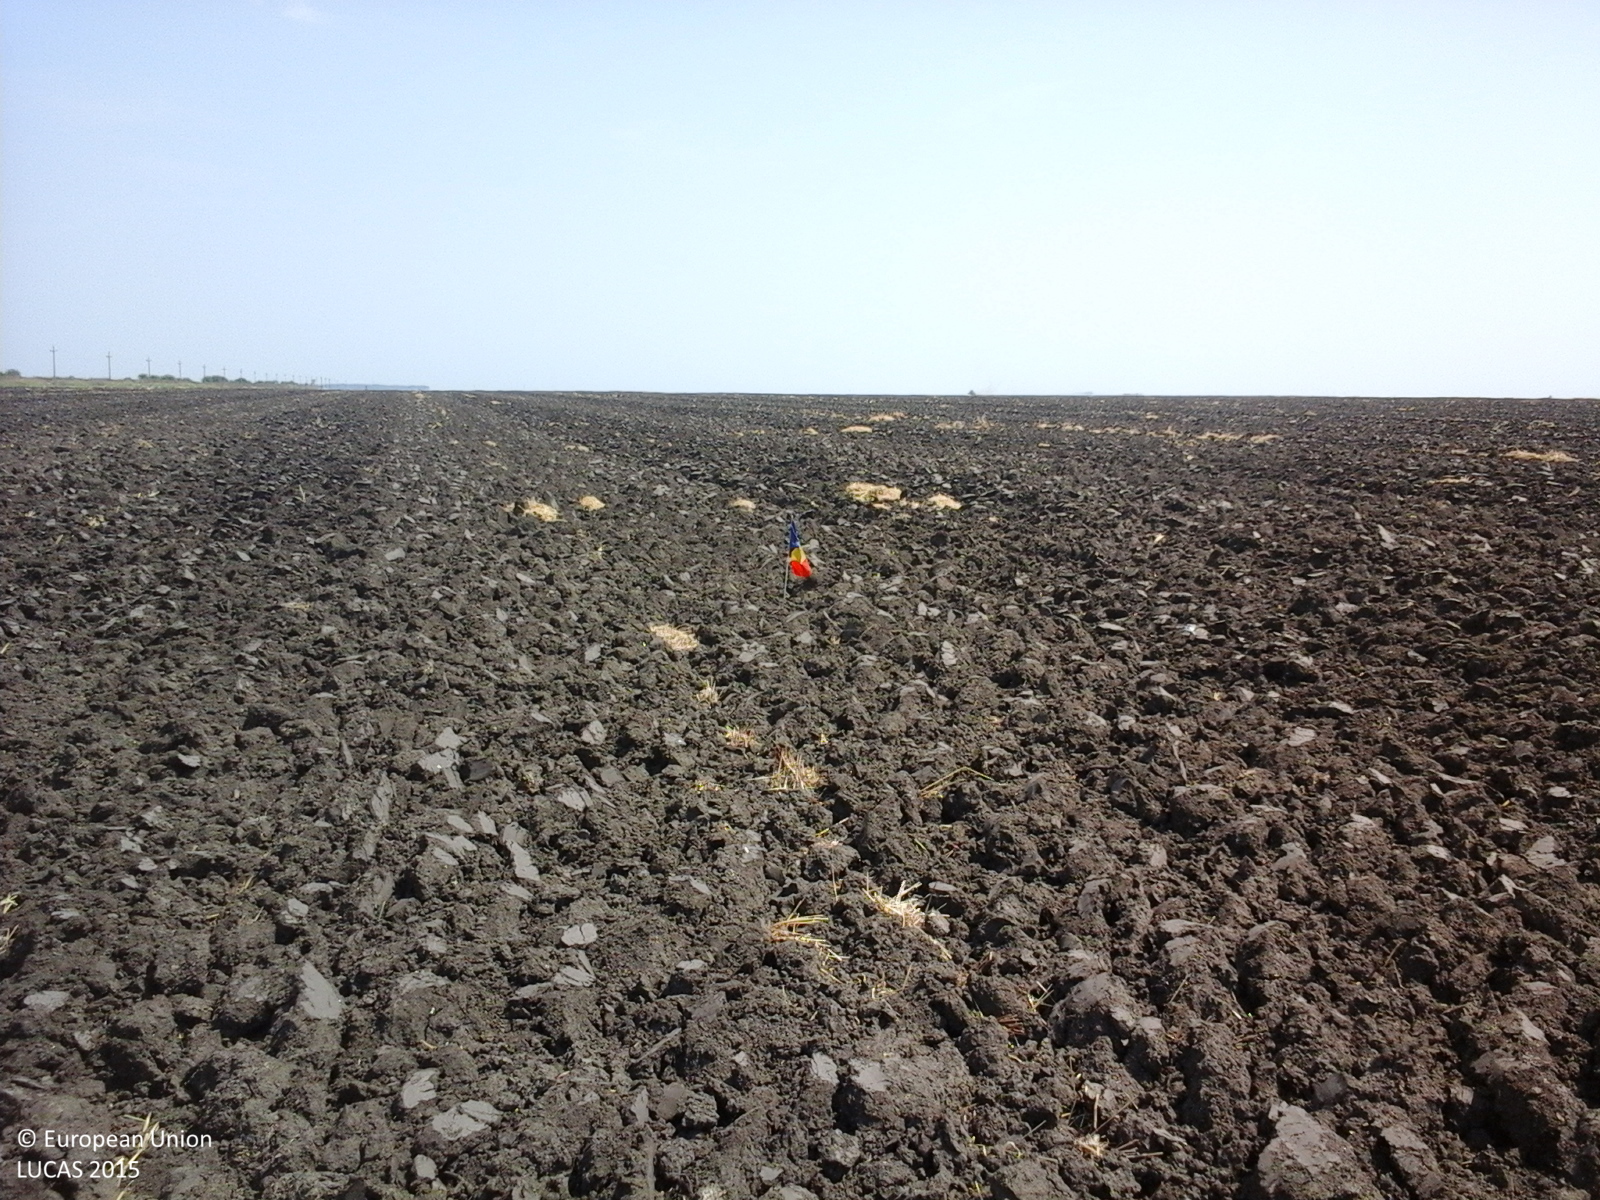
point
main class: Cropland
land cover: Barley
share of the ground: < 10 %
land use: Agriculture (excluding fallow land and kitchen gardens)
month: August
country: RO
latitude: 43.9459
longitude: 23.7203
